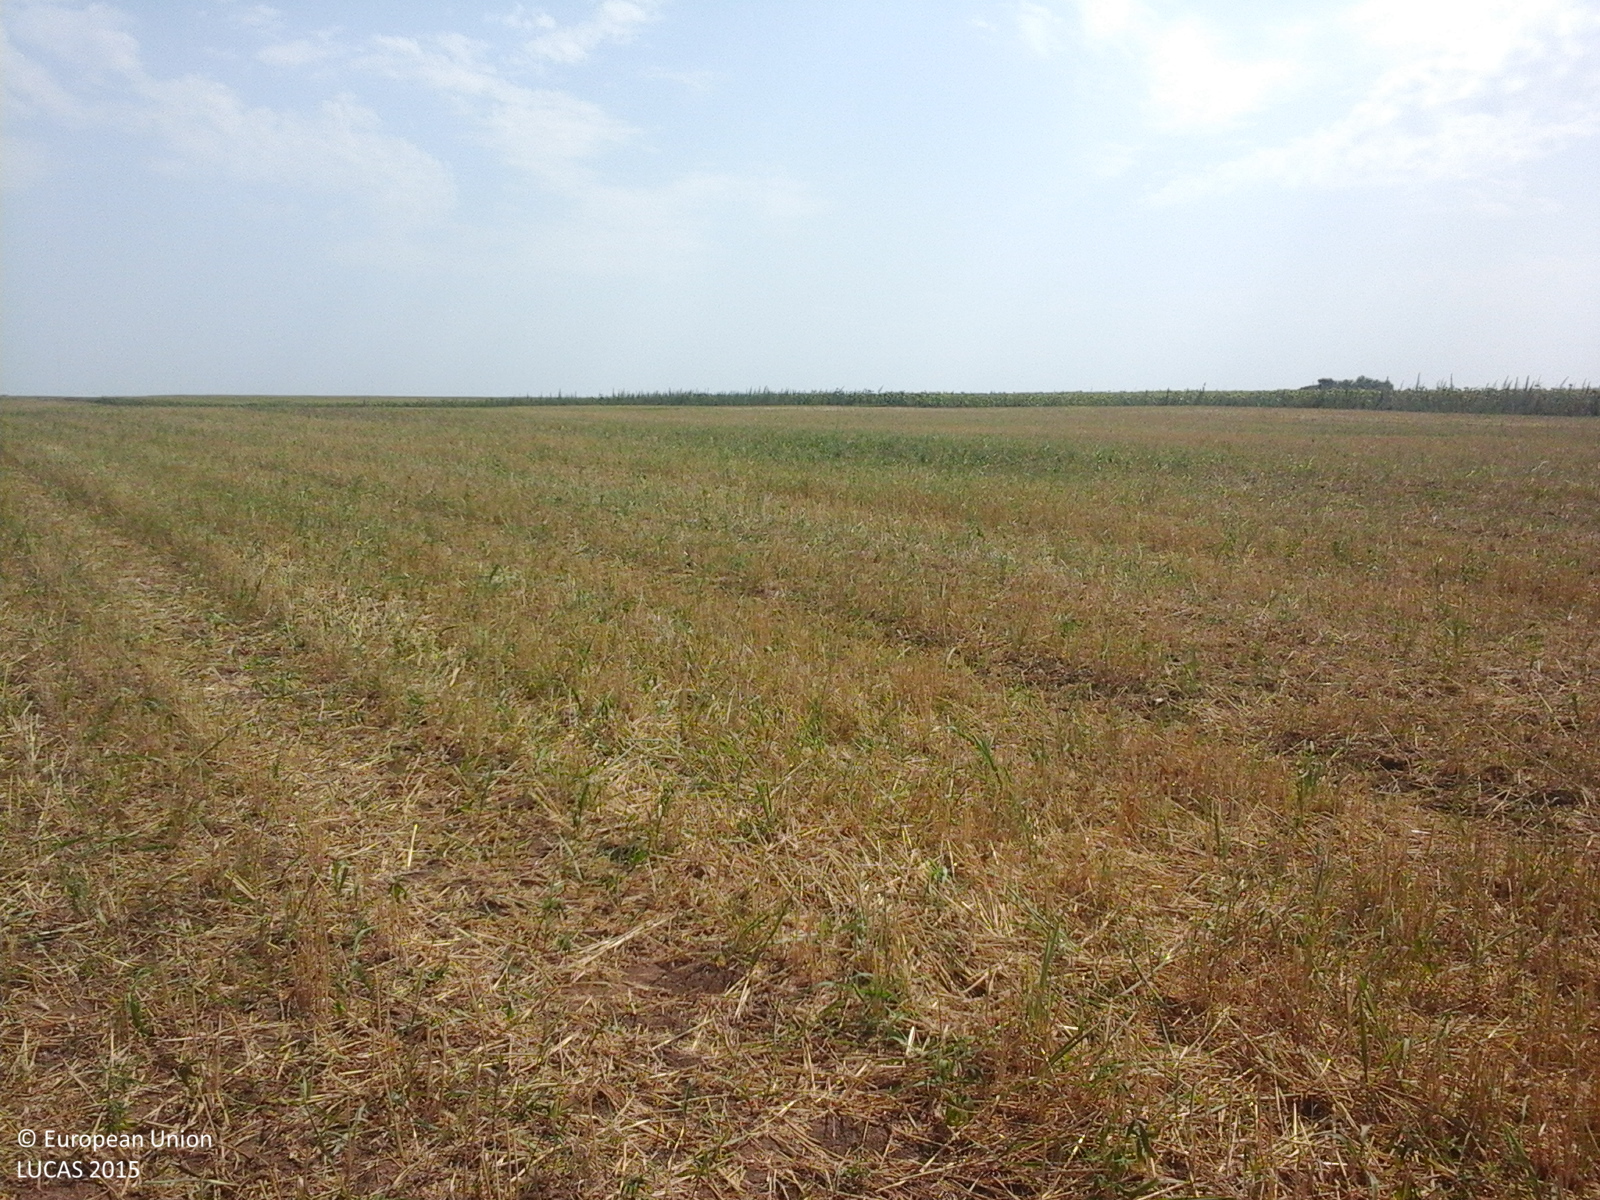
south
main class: Cropland
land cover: Common wheat
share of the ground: > 75 %
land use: Agriculture (excluding fallow land and kitchen gardens)
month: August
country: RO
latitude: 43.9271
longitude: 27.9742
